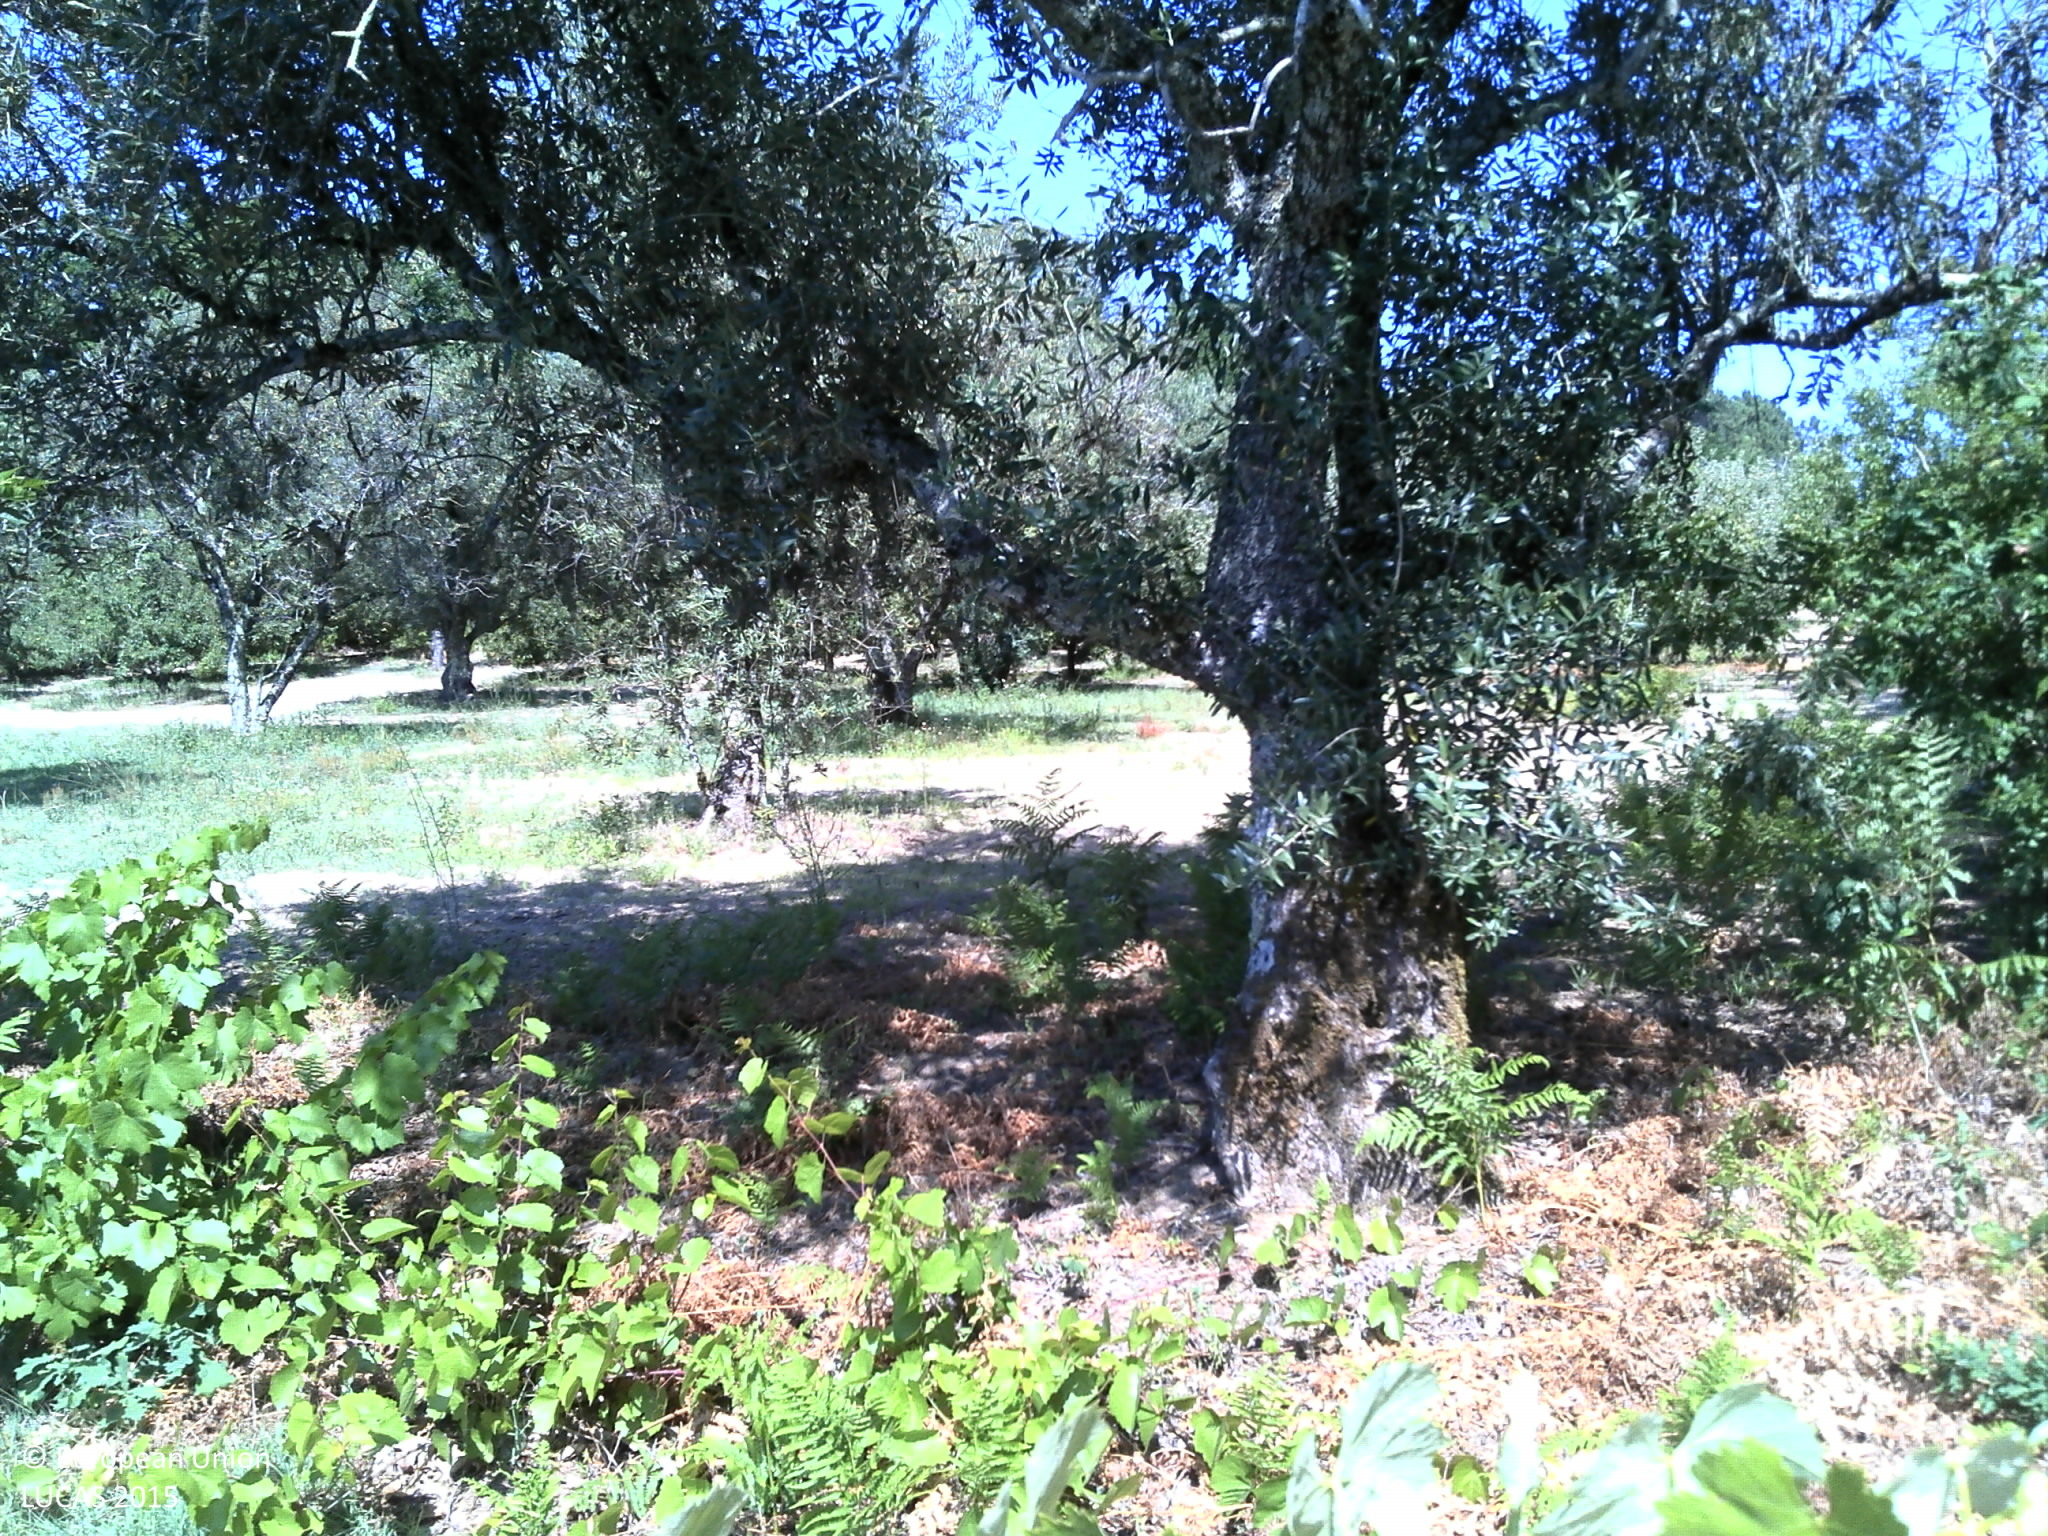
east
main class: Cropland
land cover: Vineyards
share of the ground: 10 - 25 %
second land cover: Grassland without tree/shrub cover
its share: 50 - 75 %
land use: Agriculture (excluding fallow land and kitchen gardens)
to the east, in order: Vineyards; Grassland without tree/shrub cover; Olive groves; Apple fruit; Nuts trees; Olive groves; Single bushes/trees; Vineyards; Dry stone walls; Grassland without tree/shrub cover; Single bushes/trees; Dry stone walls; Single bushes/trees; Dry stone walls; Tracks; Dry stone walls; Vineyards; Other fresh vegetables; Potatoes; Other fresh vegetables; Dry stone walls; Pine dominated coniferous woodland
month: July
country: PT
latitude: 40.7476
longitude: -7.8053
